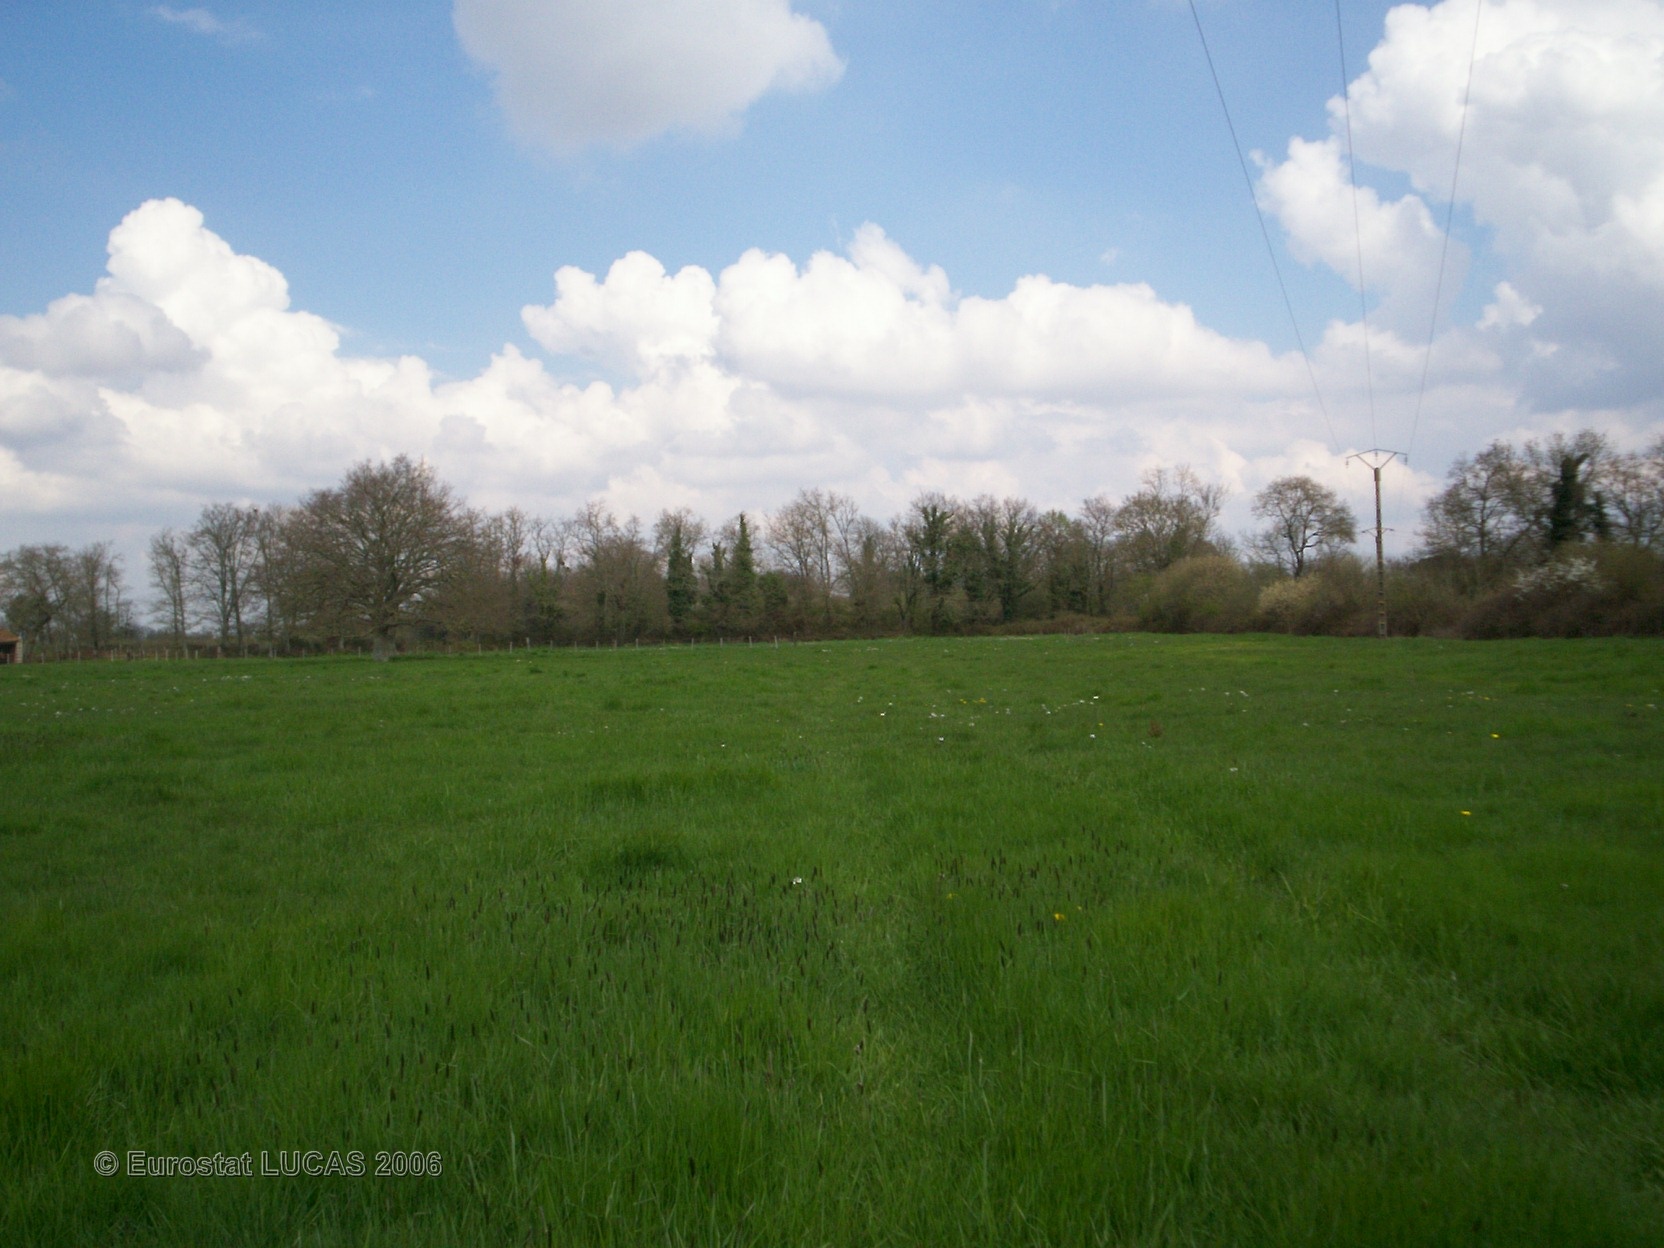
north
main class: Grassland
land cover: Grassland without tree/shrub cover
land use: Agriculture (excluding fallow land and kitchen gardens)
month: April
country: FR
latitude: 47.0774
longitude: -1.2987
